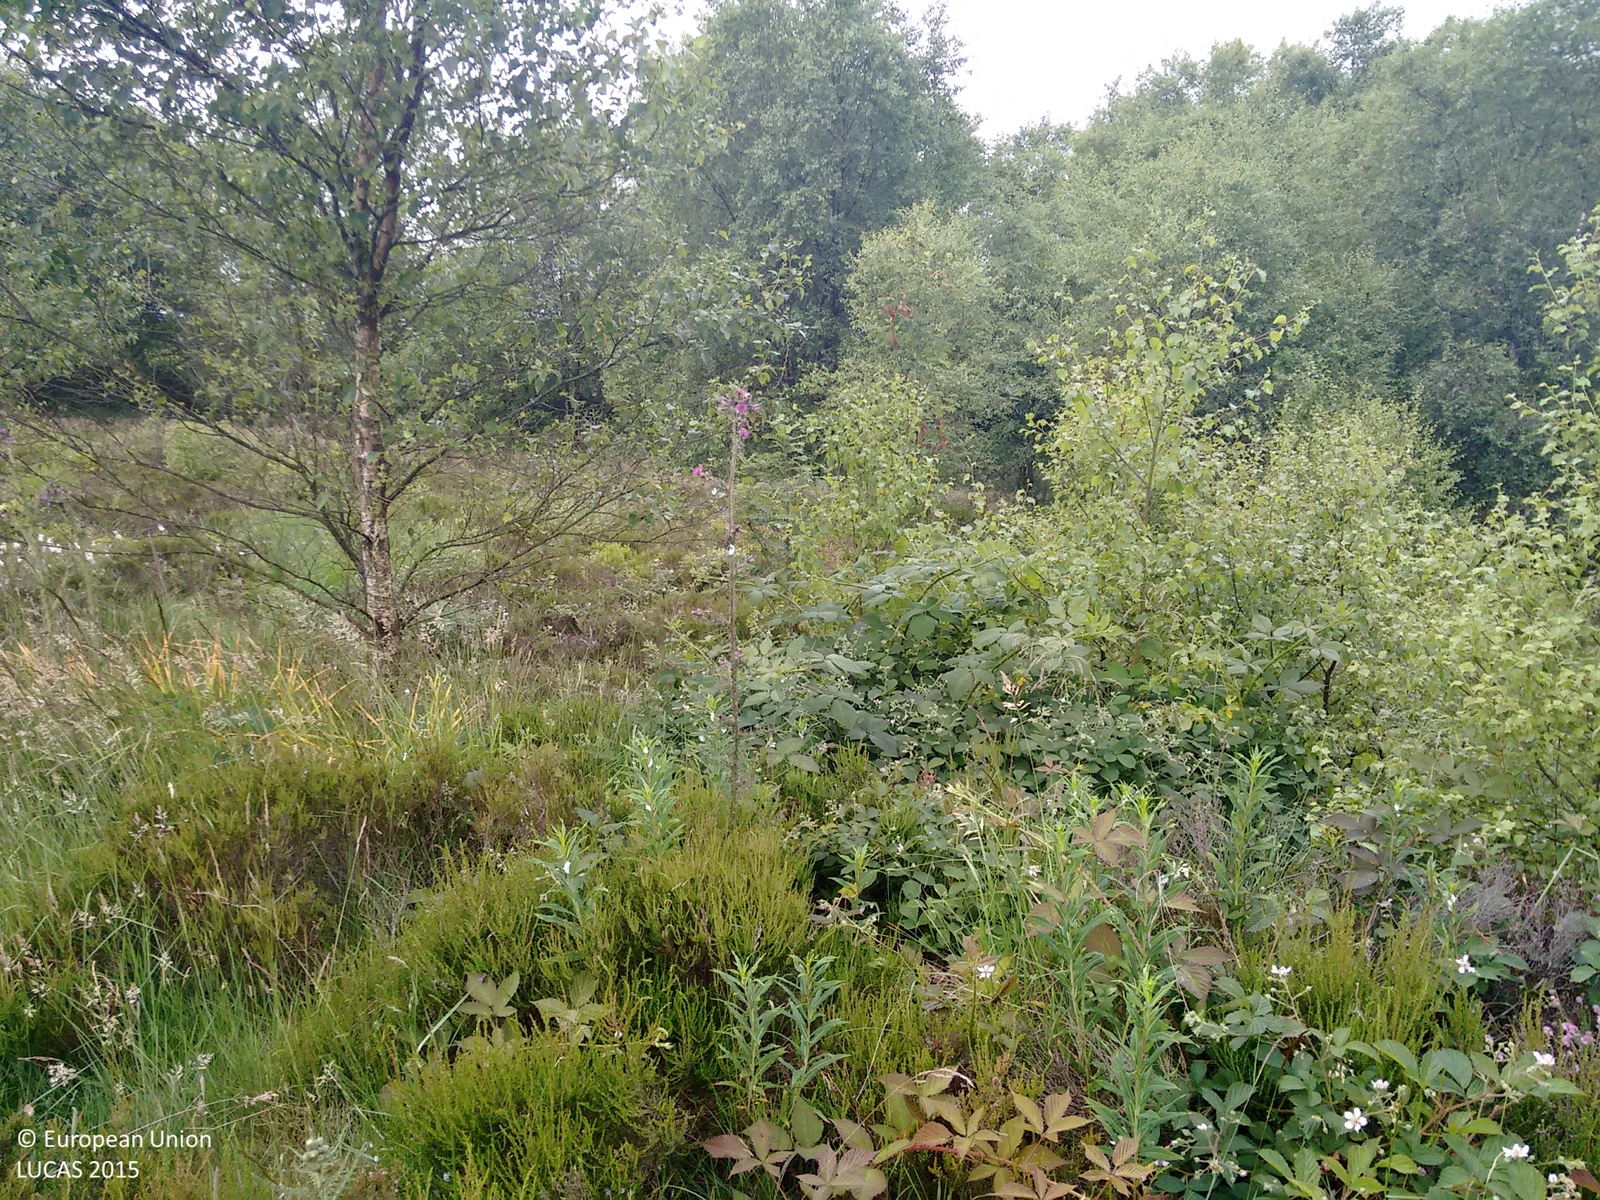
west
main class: Shrubland
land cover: Shrubland with sparse tree cover
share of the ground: > 75 %
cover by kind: shrubs 95 %, broadleaved forest trees 5 %
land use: Semi-natural and natural areas not in use
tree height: > 5 m
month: July
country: GB
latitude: 53.1970
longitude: -1.5016
